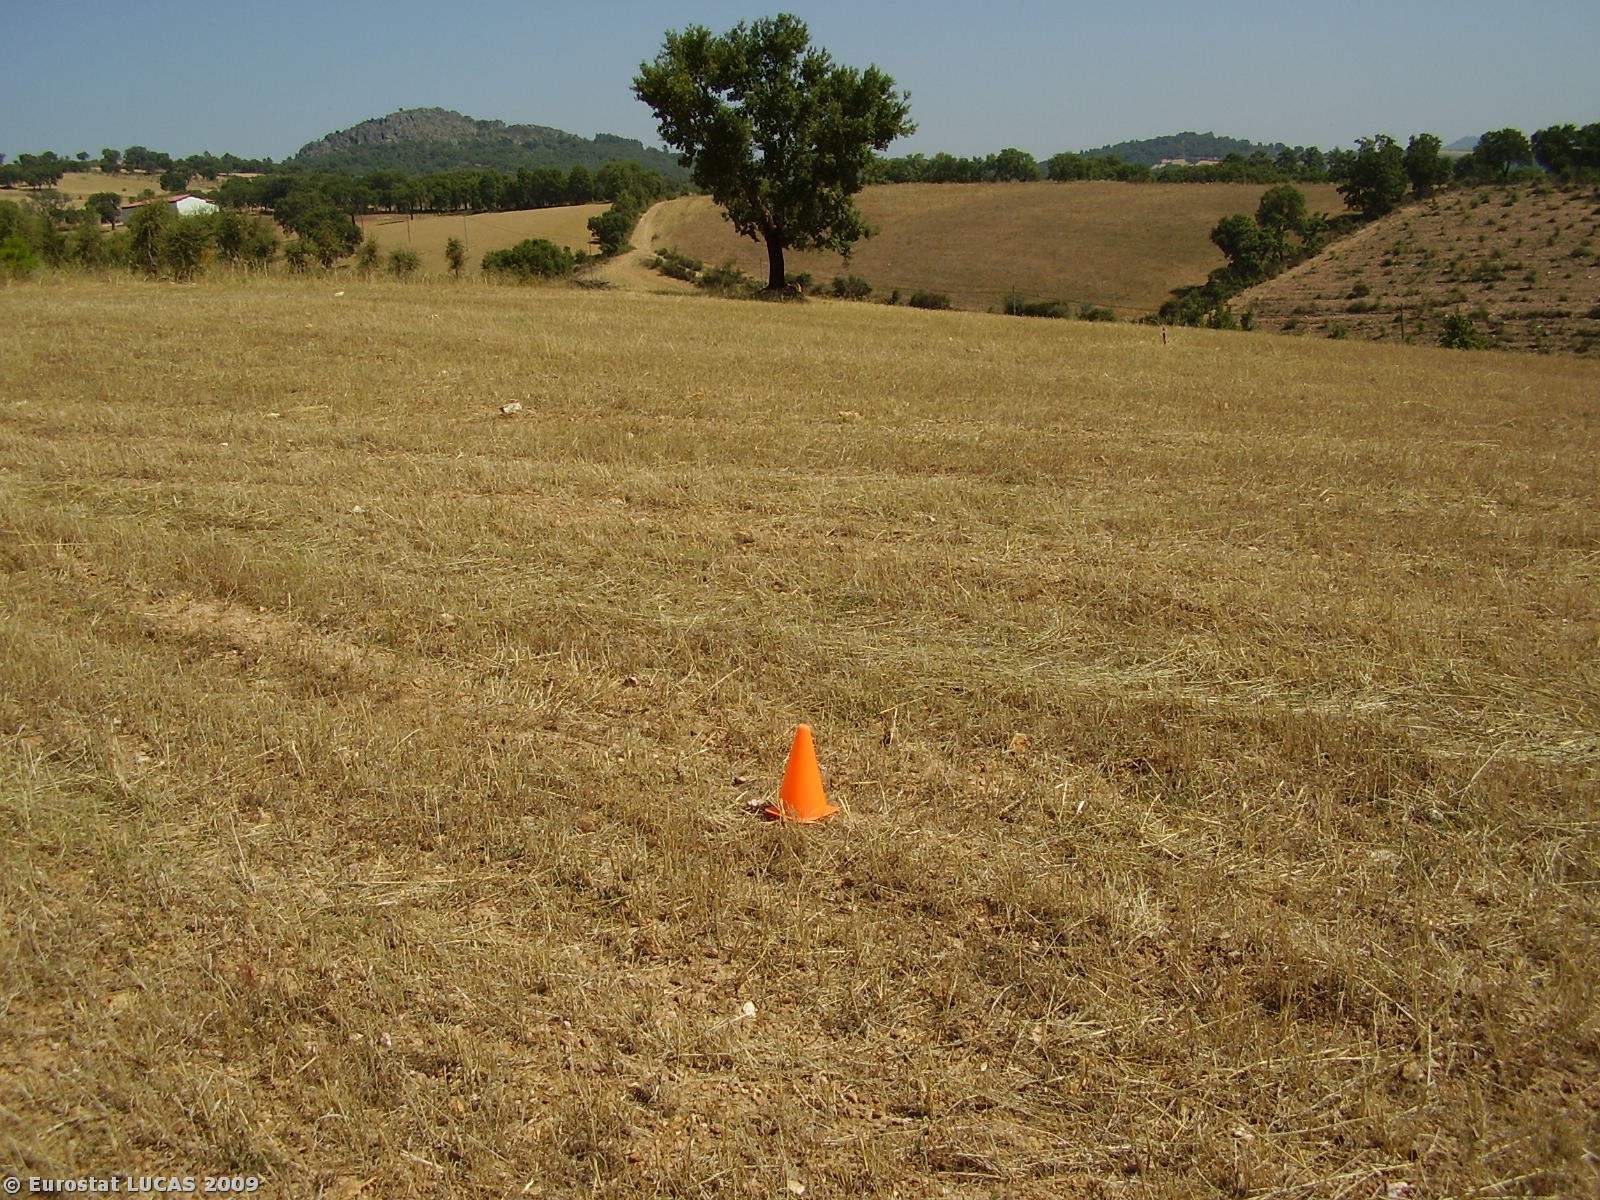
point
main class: Cropland
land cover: Common wheat
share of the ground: < 10 %
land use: Agriculture (excluding fallow land and kitchen gardens)
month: August
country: PT
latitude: 41.3079
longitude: -6.7194
